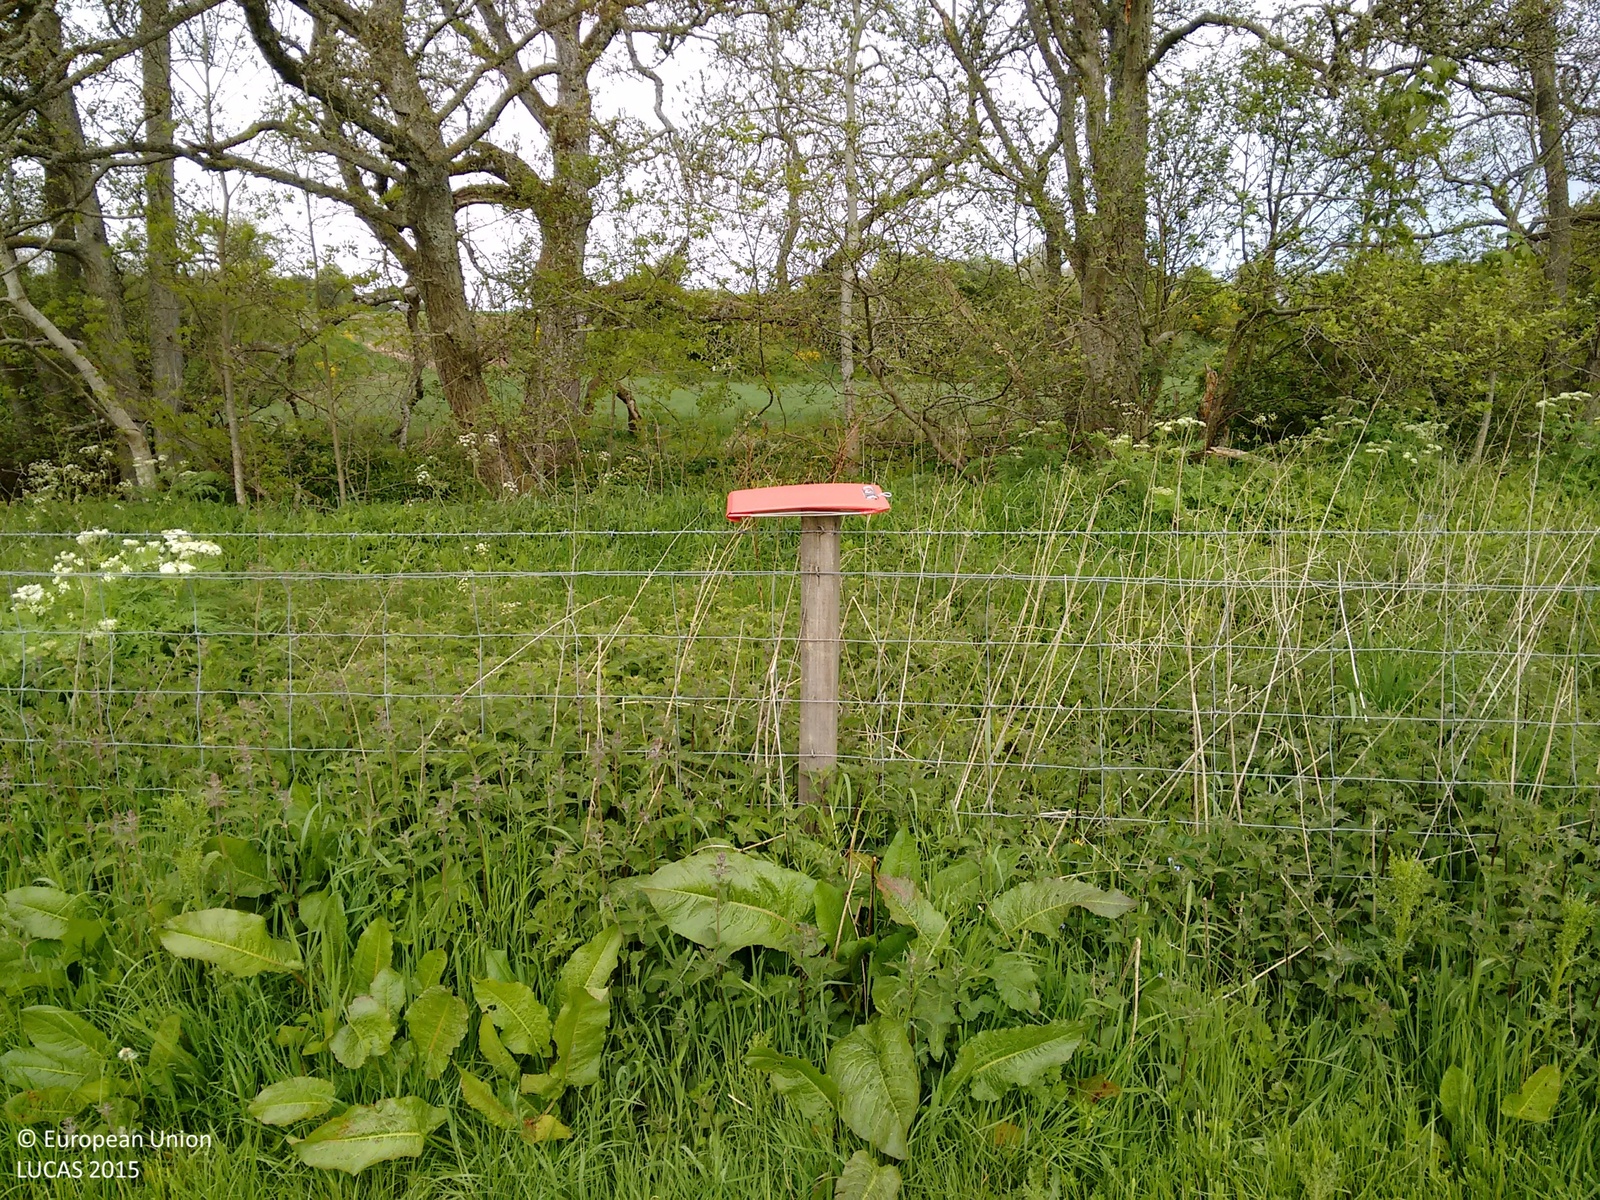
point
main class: Grassland
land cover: Grassland without tree/shrub cover
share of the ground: > 75 %
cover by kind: herbaceous plants 100 %
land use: Agriculture (excluding fallow land and kitchen gardens)
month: June
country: GB
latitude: 56.4533
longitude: -3.5266
